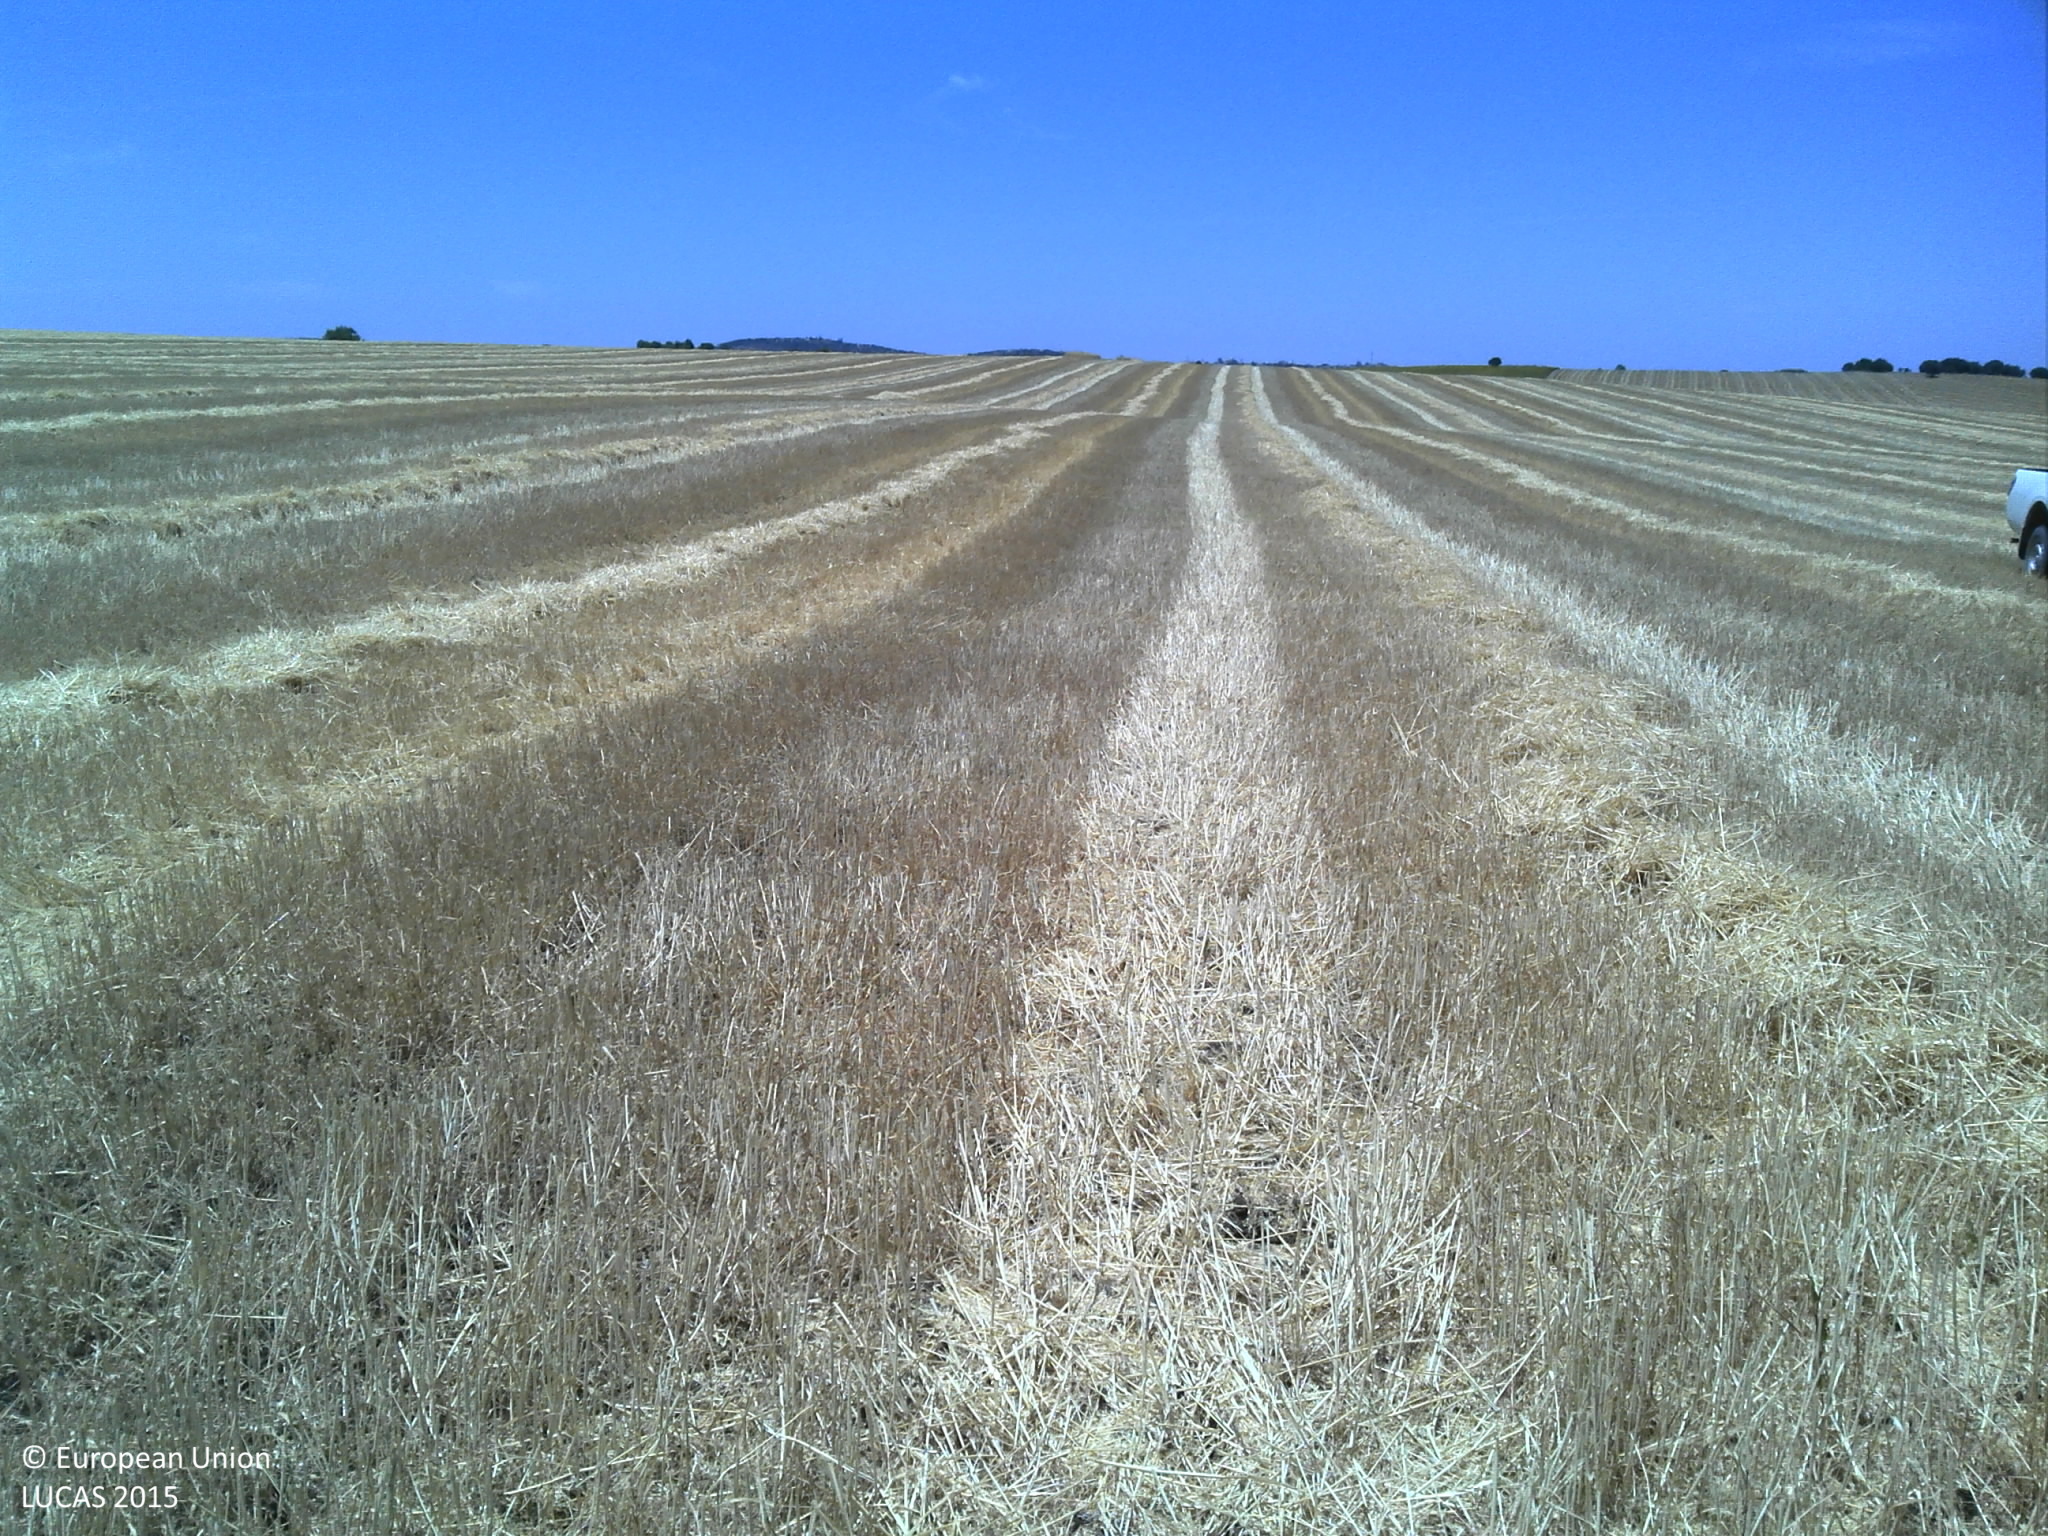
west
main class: Cropland
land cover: Common wheat
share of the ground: > 75 %
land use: Agriculture (excluding fallow land and kitchen gardens)
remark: Harvested field
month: June
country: PT
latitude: 37.9362
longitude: -7.5294
